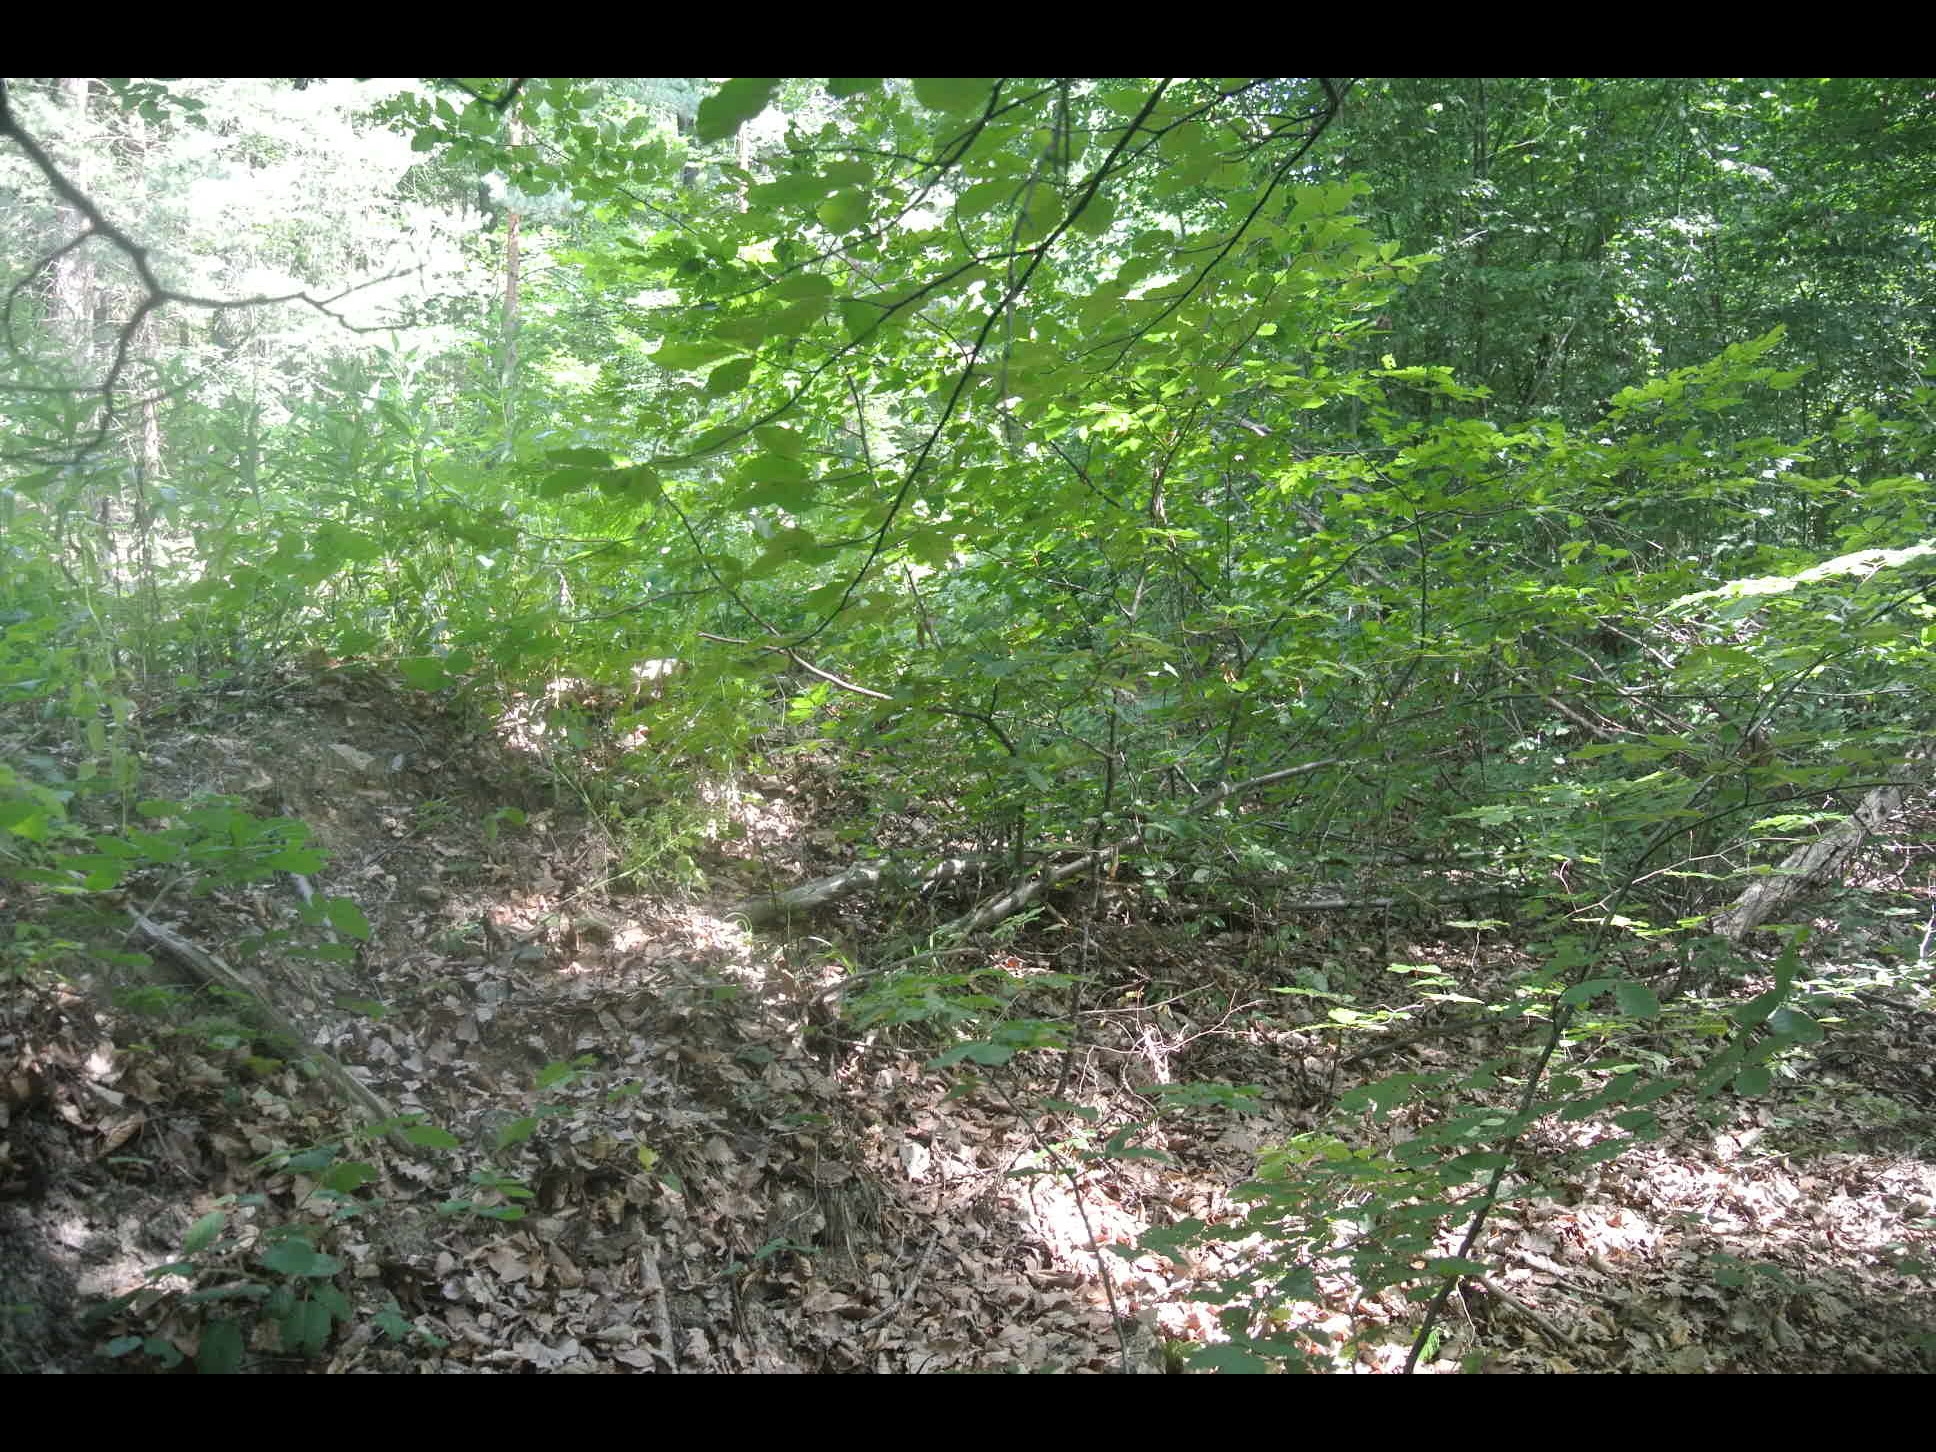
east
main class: Woodland
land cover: Broadleaved woodland
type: beech forest
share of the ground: > 75 %
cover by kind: broadleaved forest trees 95 %, coniferous forest trees 5 %
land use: Forestry
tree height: > 5 m
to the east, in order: Broadleaved woodland; Tracks; Pine dominated mixed woodland; Tracks; Pine dominated mixed woodland; Pine dominated coniferous woodland; Pine dominated mixed woodland; Other coniferous woodland
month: July
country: AT
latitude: 47.4039
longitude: 16.4301
